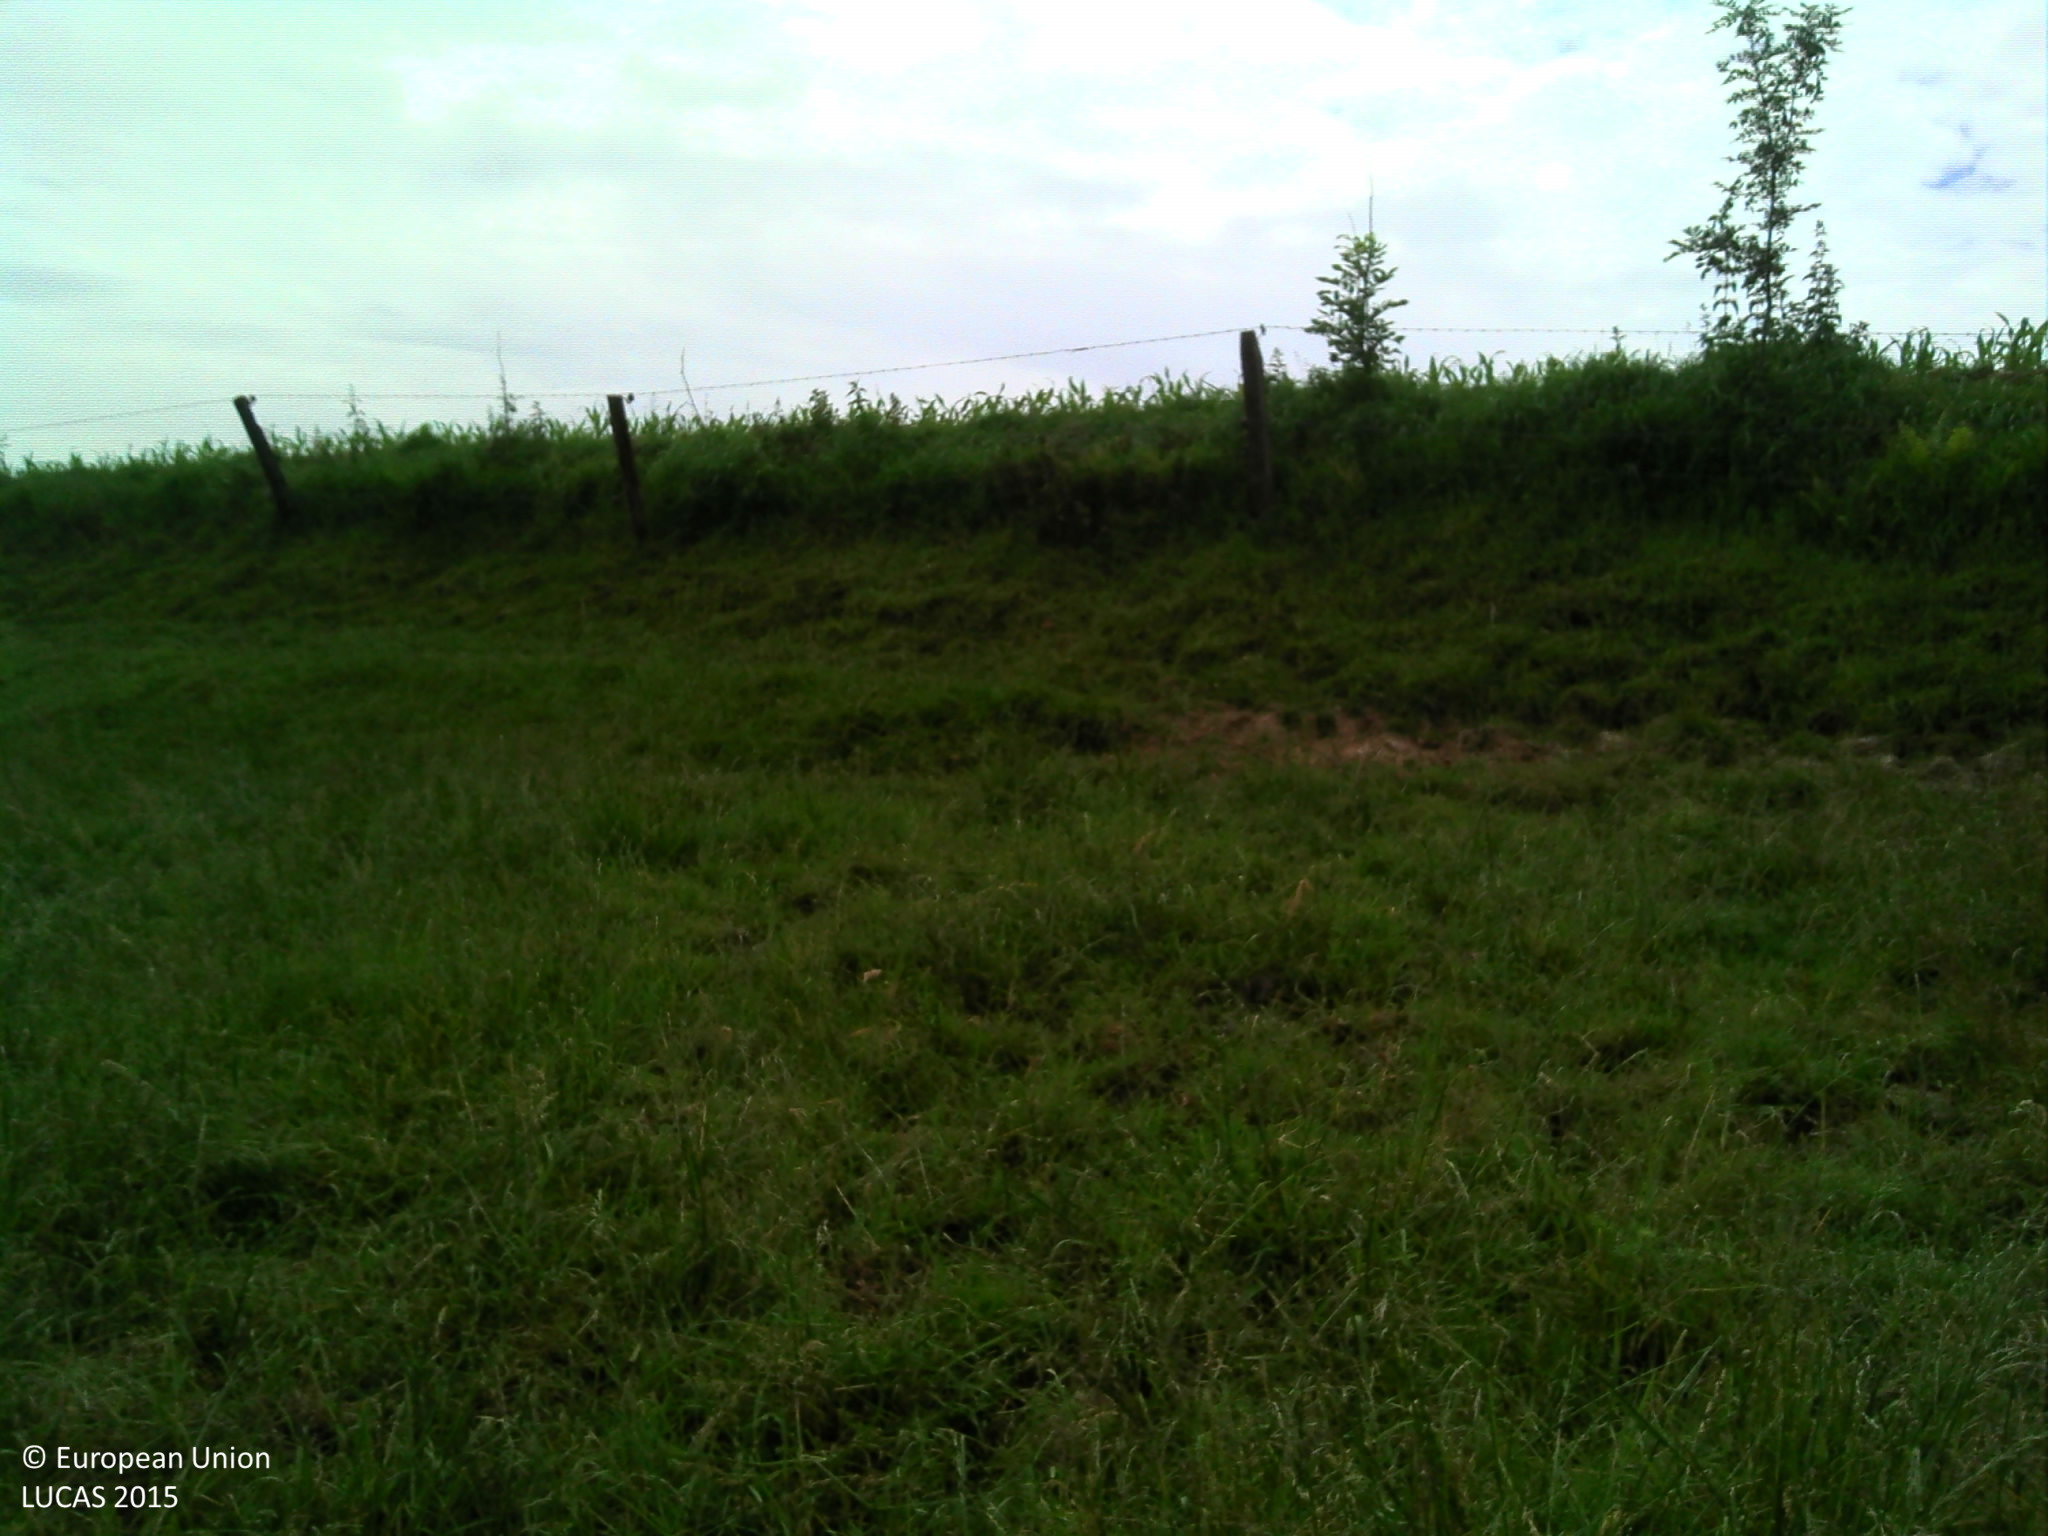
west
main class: Grassland
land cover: Grassland without tree/shrub cover
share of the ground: > 75 %
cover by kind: herbaceous plants 100 %
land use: Agriculture (excluding fallow land and kitchen gardens)
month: June
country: BE
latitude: 50.7651
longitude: 3.6553
